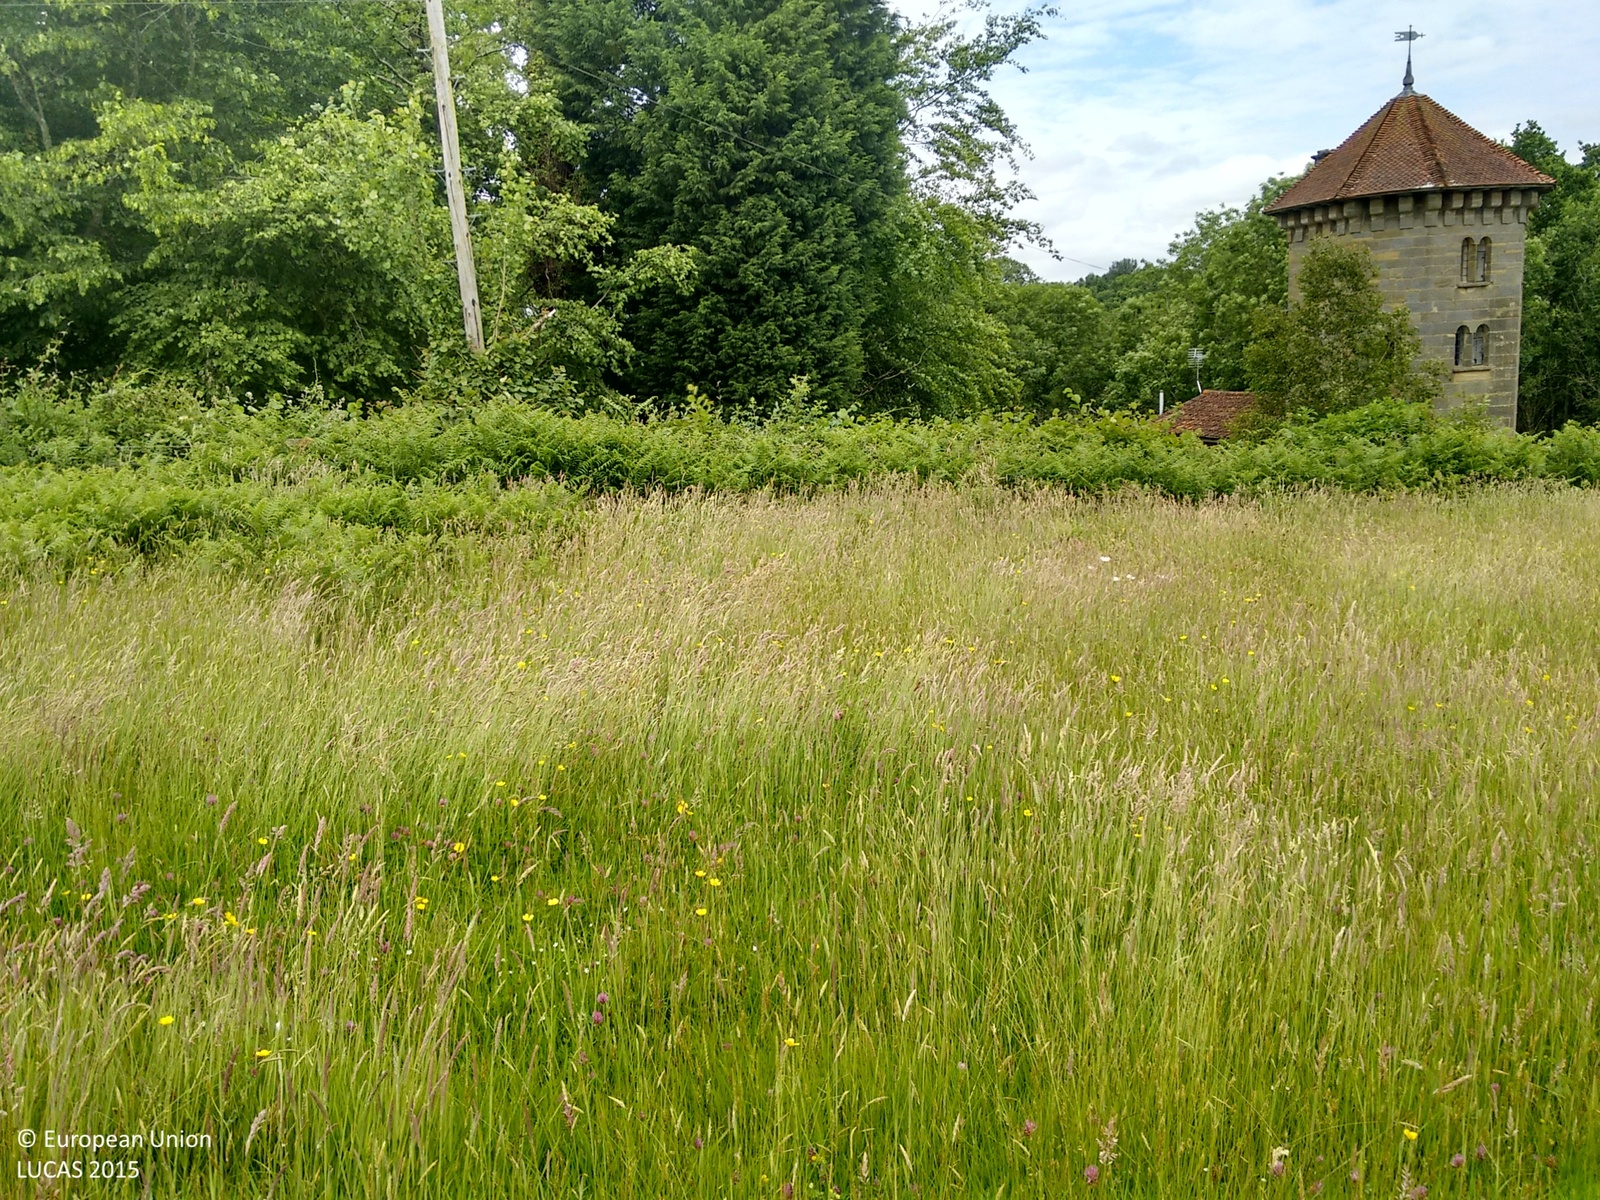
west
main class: Grassland
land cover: Grassland without tree/shrub cover
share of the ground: > 75 %
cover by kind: herbaceous plants 100 %
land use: Agriculture (excluding fallow land and kitchen gardens)
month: June
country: GB
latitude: 50.9214
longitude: 0.4261
